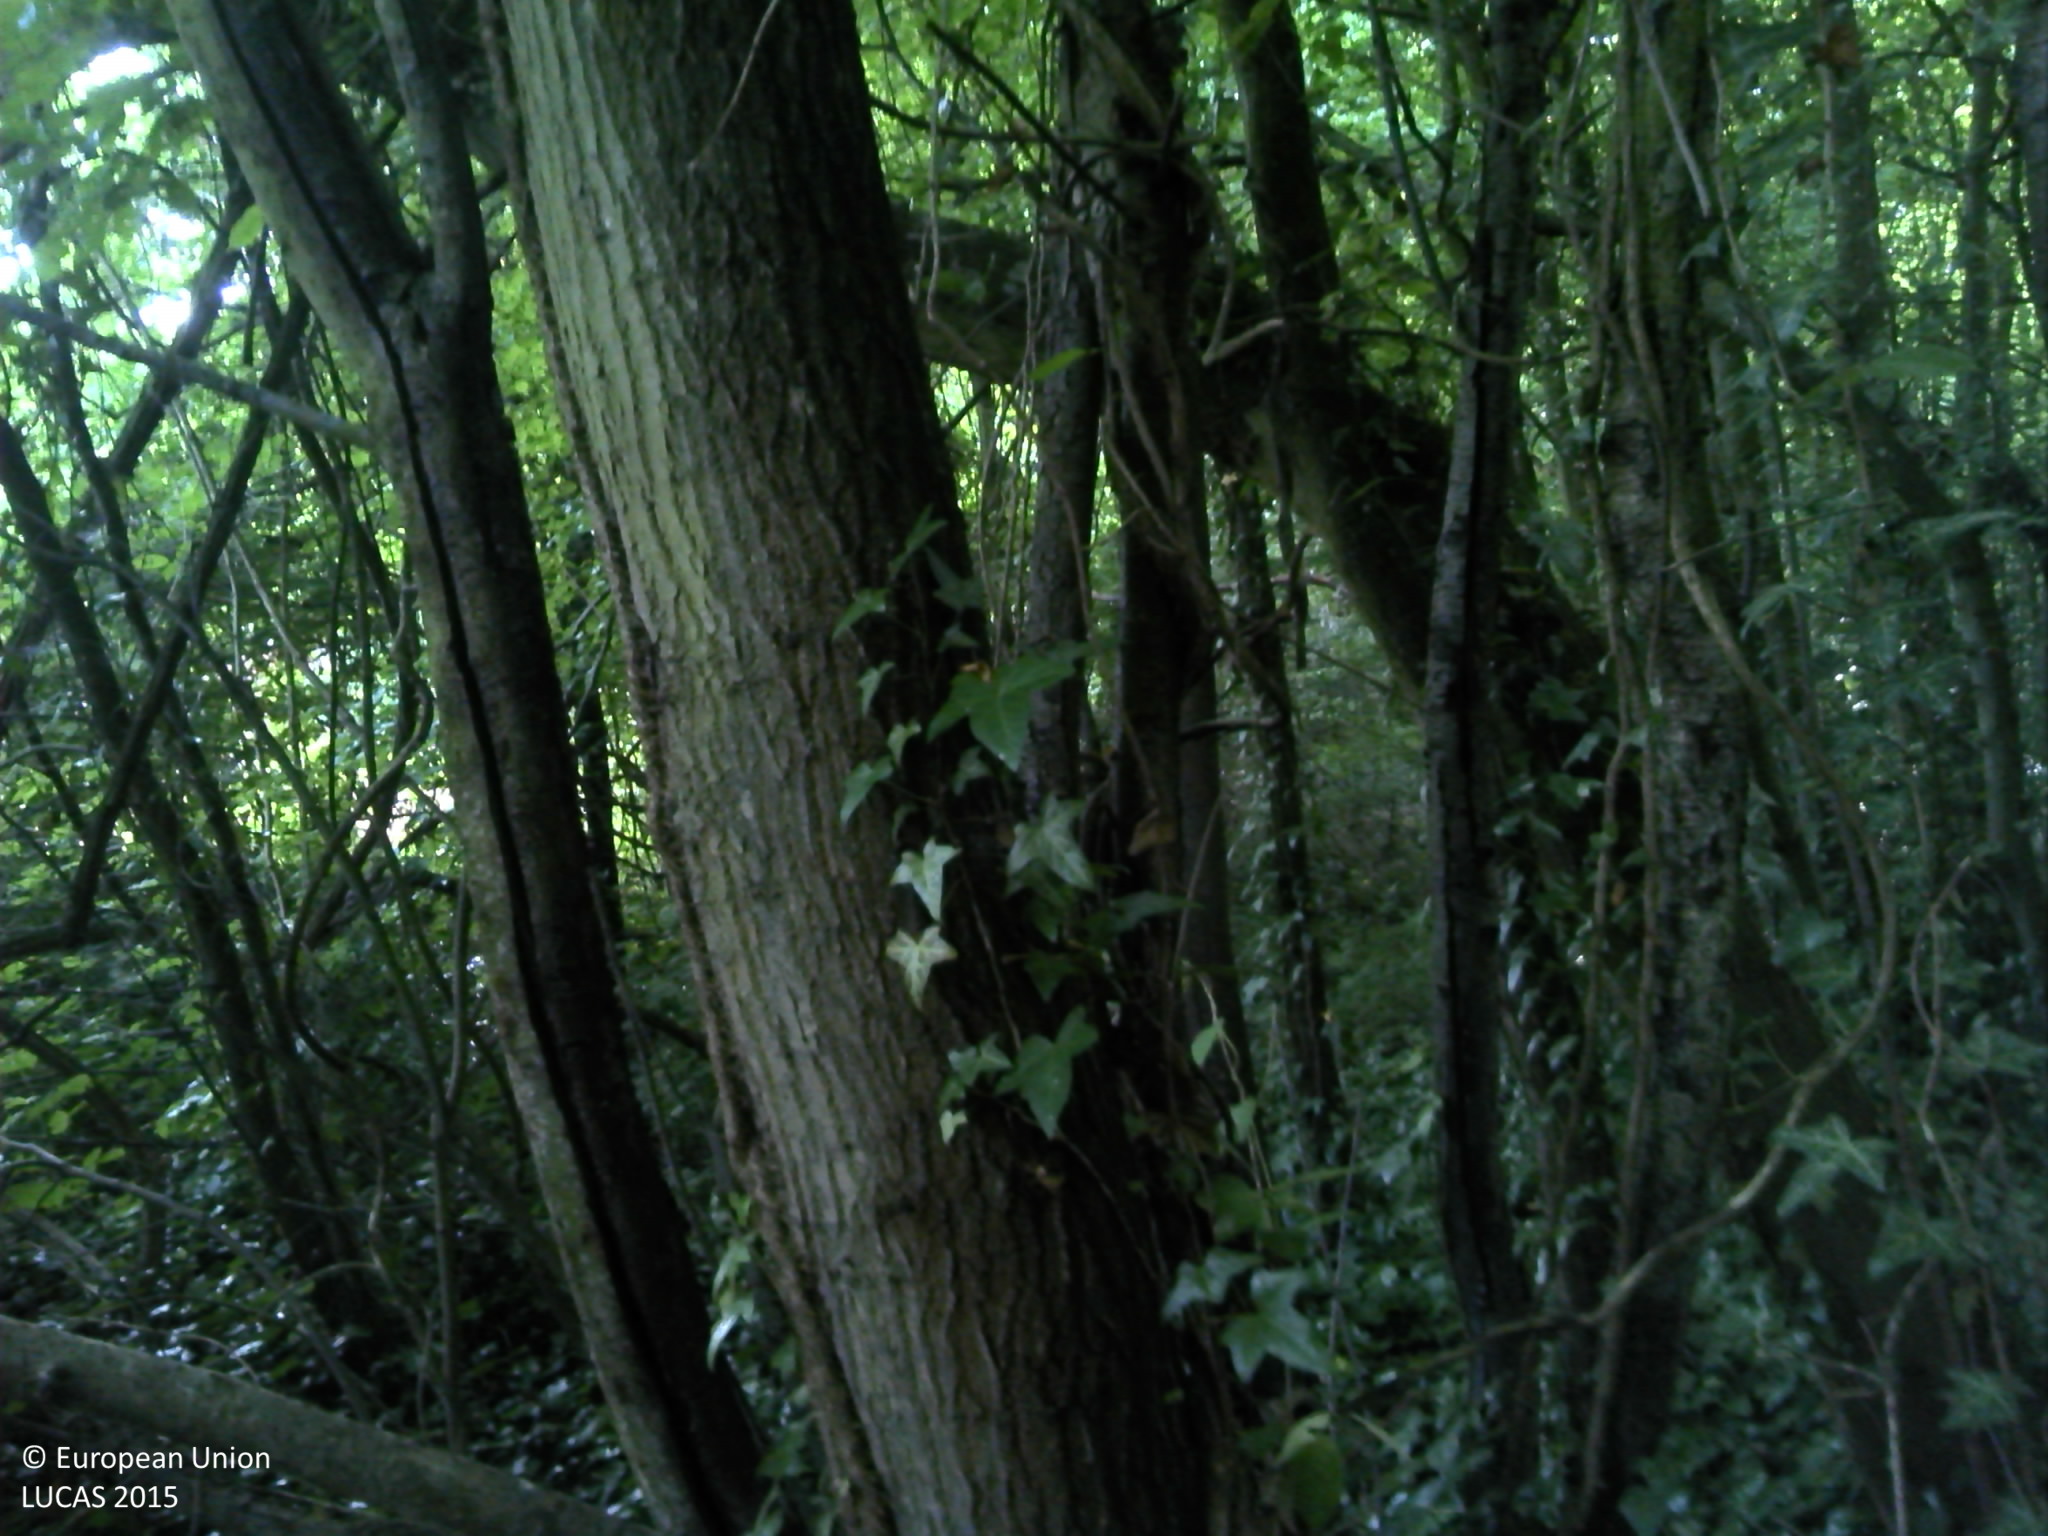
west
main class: Woodland
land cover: Broadleaved woodland
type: beech forest
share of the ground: > 75 %
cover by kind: broadleaved forest trees 100 %
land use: Forestry
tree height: > 5 m
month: June
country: FR
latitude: 49.2187
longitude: 6.1417
